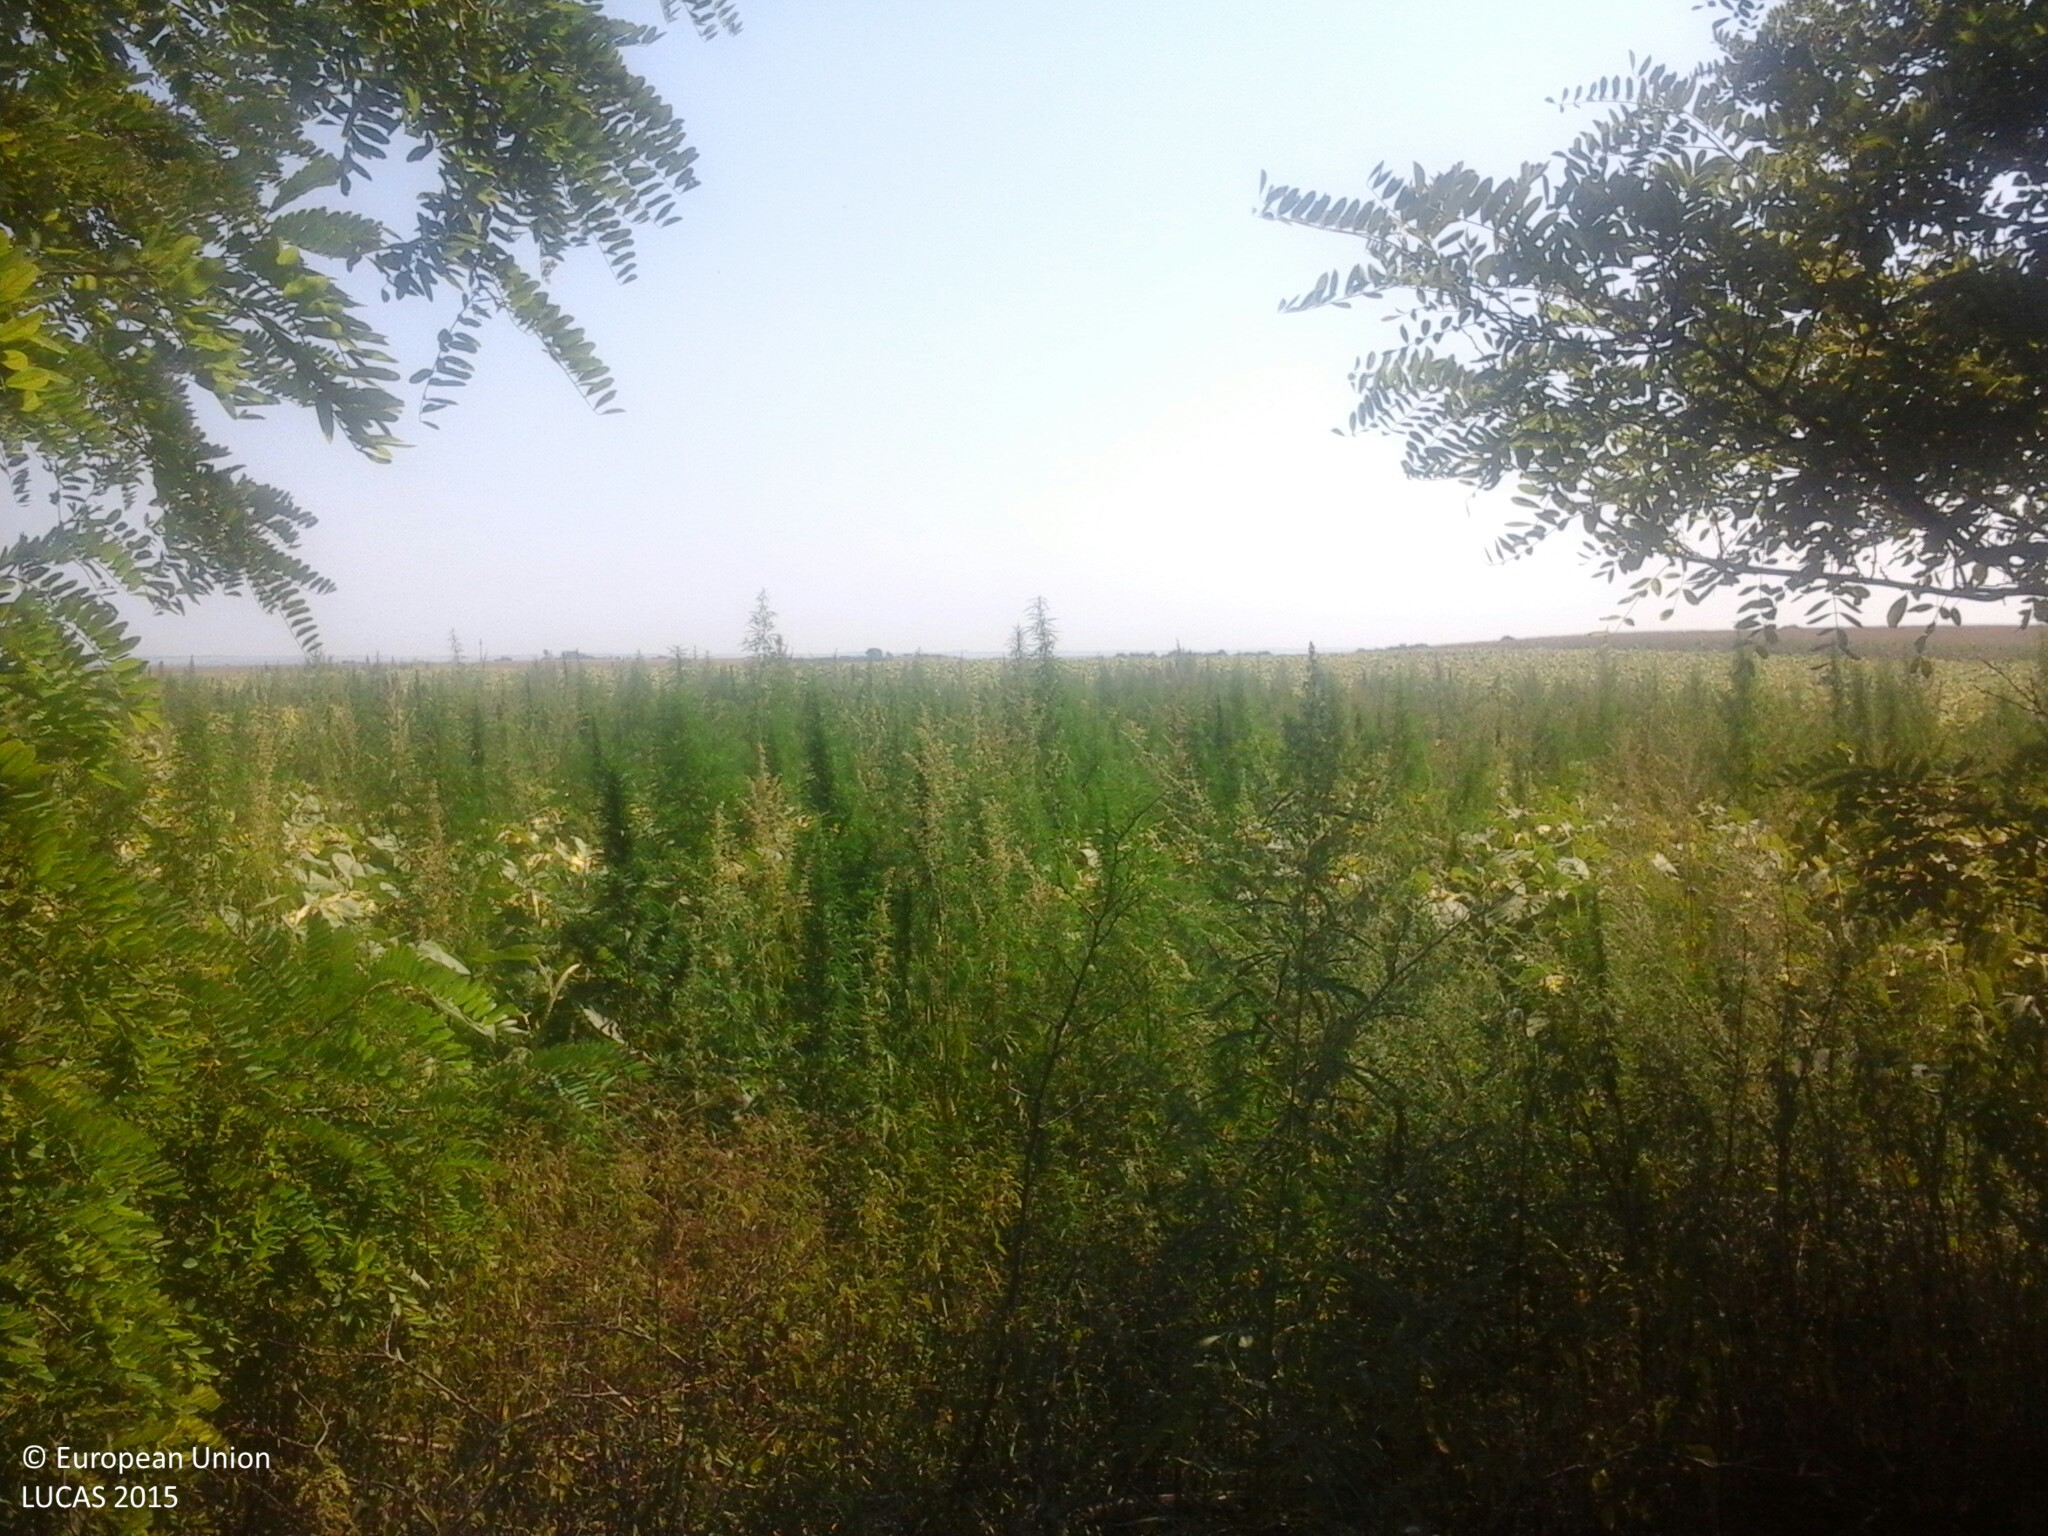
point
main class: Cropland
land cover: Sunflower
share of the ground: > 75 %
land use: Agriculture (excluding fallow land and kitchen gardens)
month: August
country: HU
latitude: 46.9390
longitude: 18.4582
